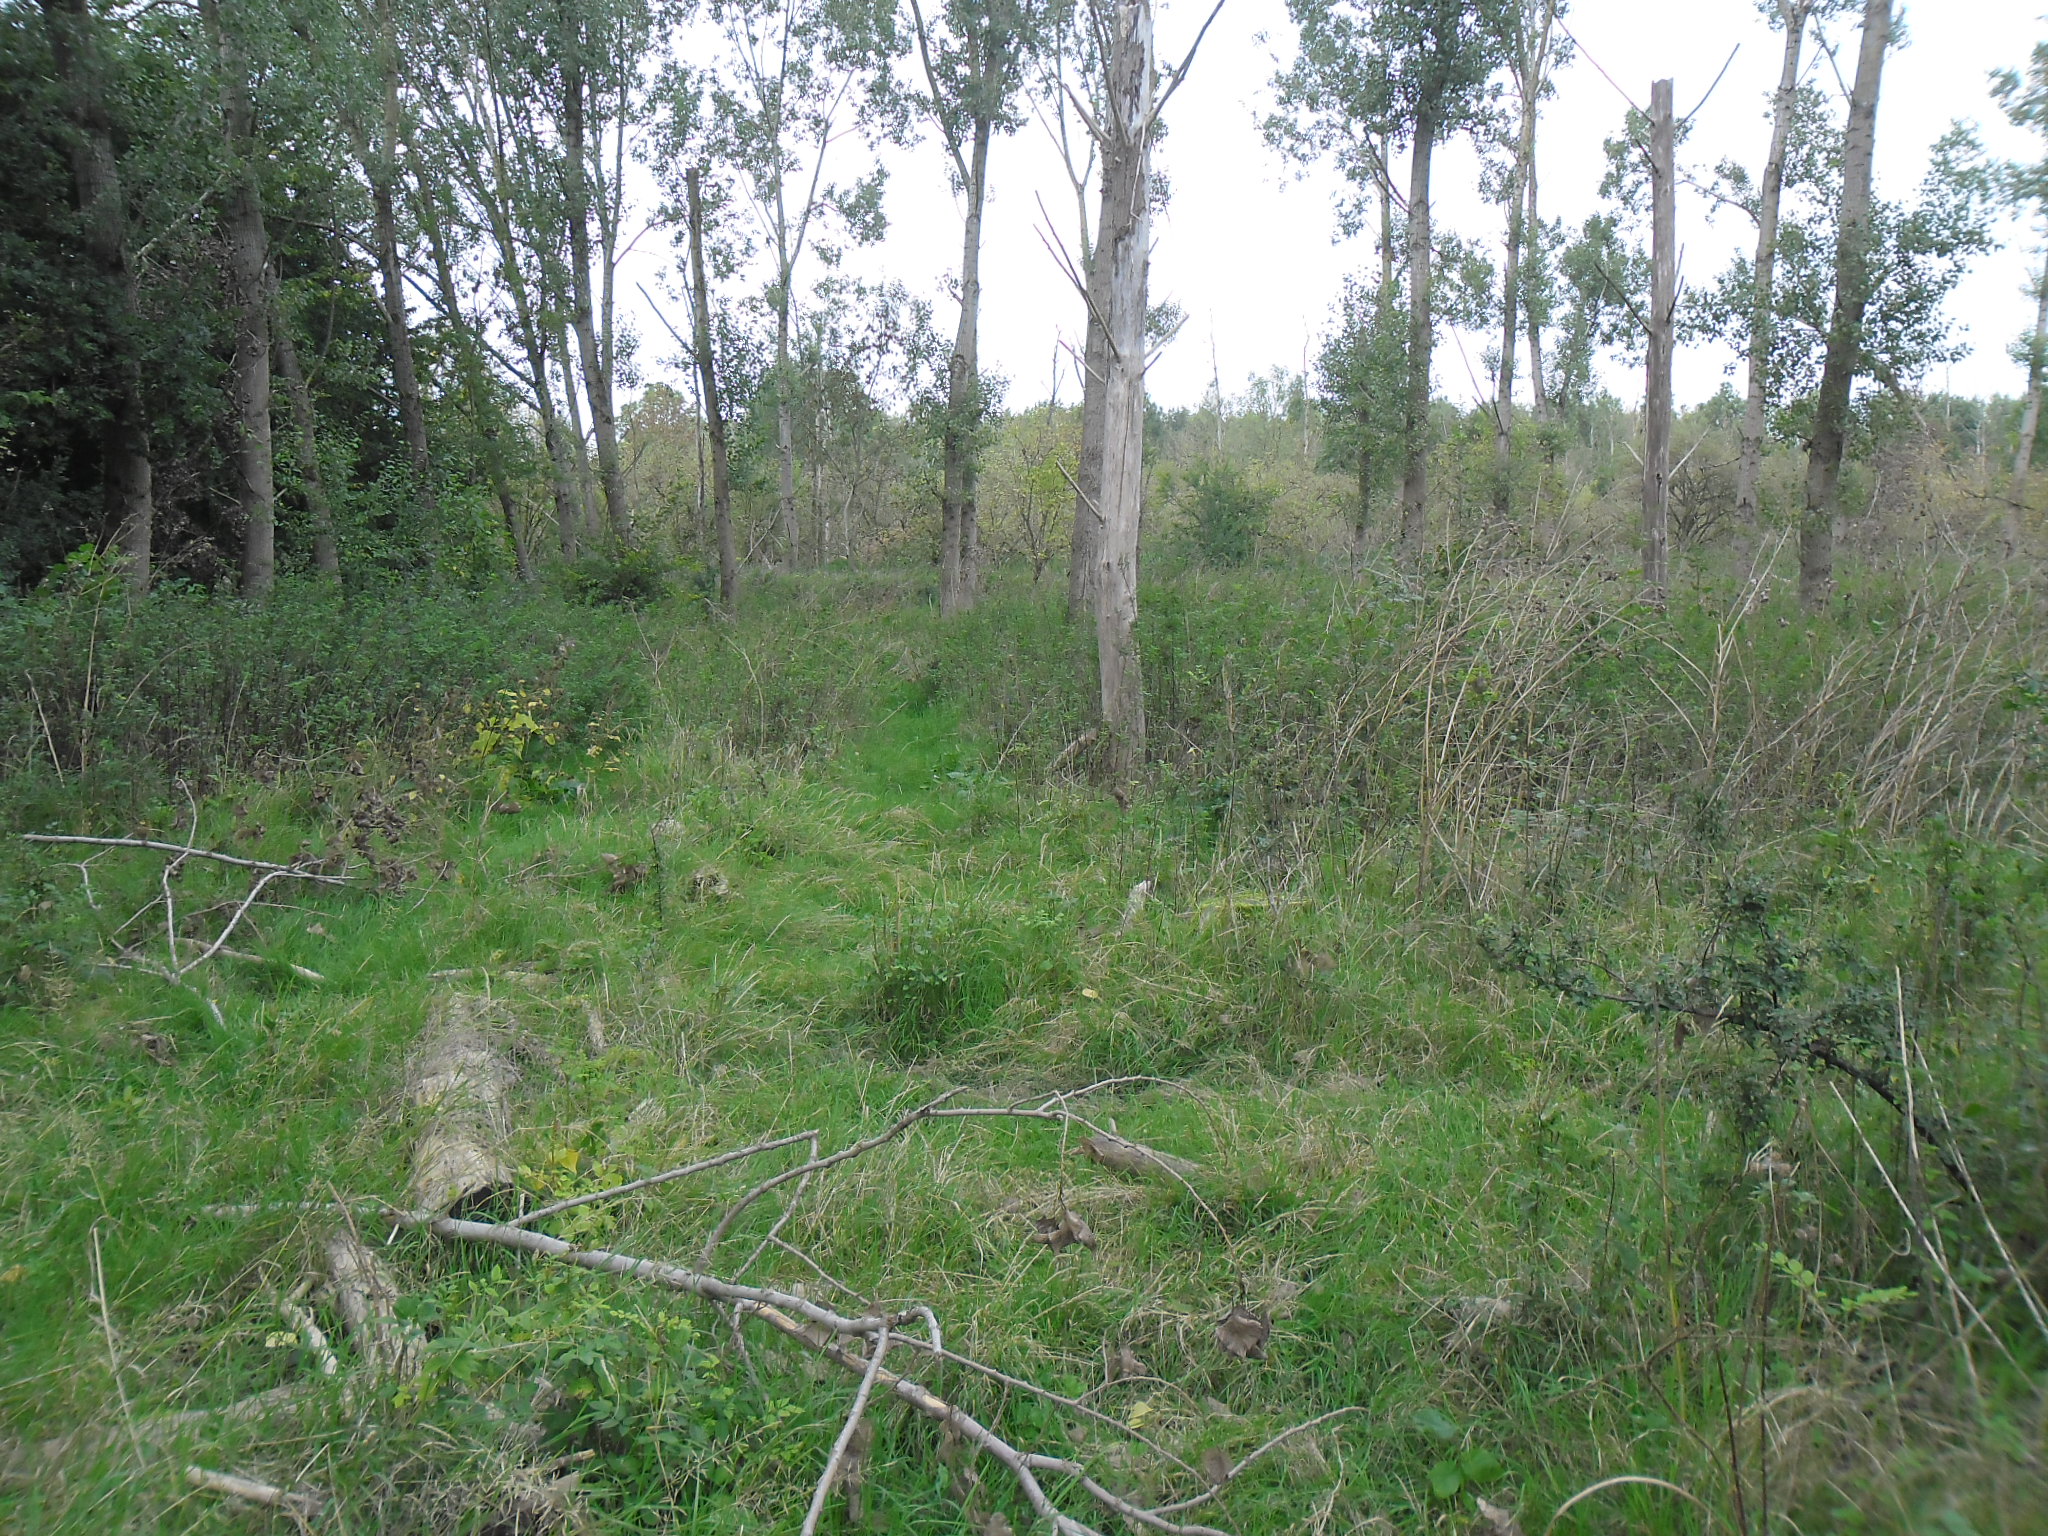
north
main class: Woodland
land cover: Broadleaved woodland
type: non-riverine alder, birch or aspen forest
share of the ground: > 75 %
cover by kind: broadleaved forest trees 80 %, herbaceous plants 20 %
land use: Forestry
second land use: Amenities, museums, leisure
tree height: > 5 m
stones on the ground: < 10 %
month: September
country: NL
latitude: 52.2910
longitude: 5.4680
